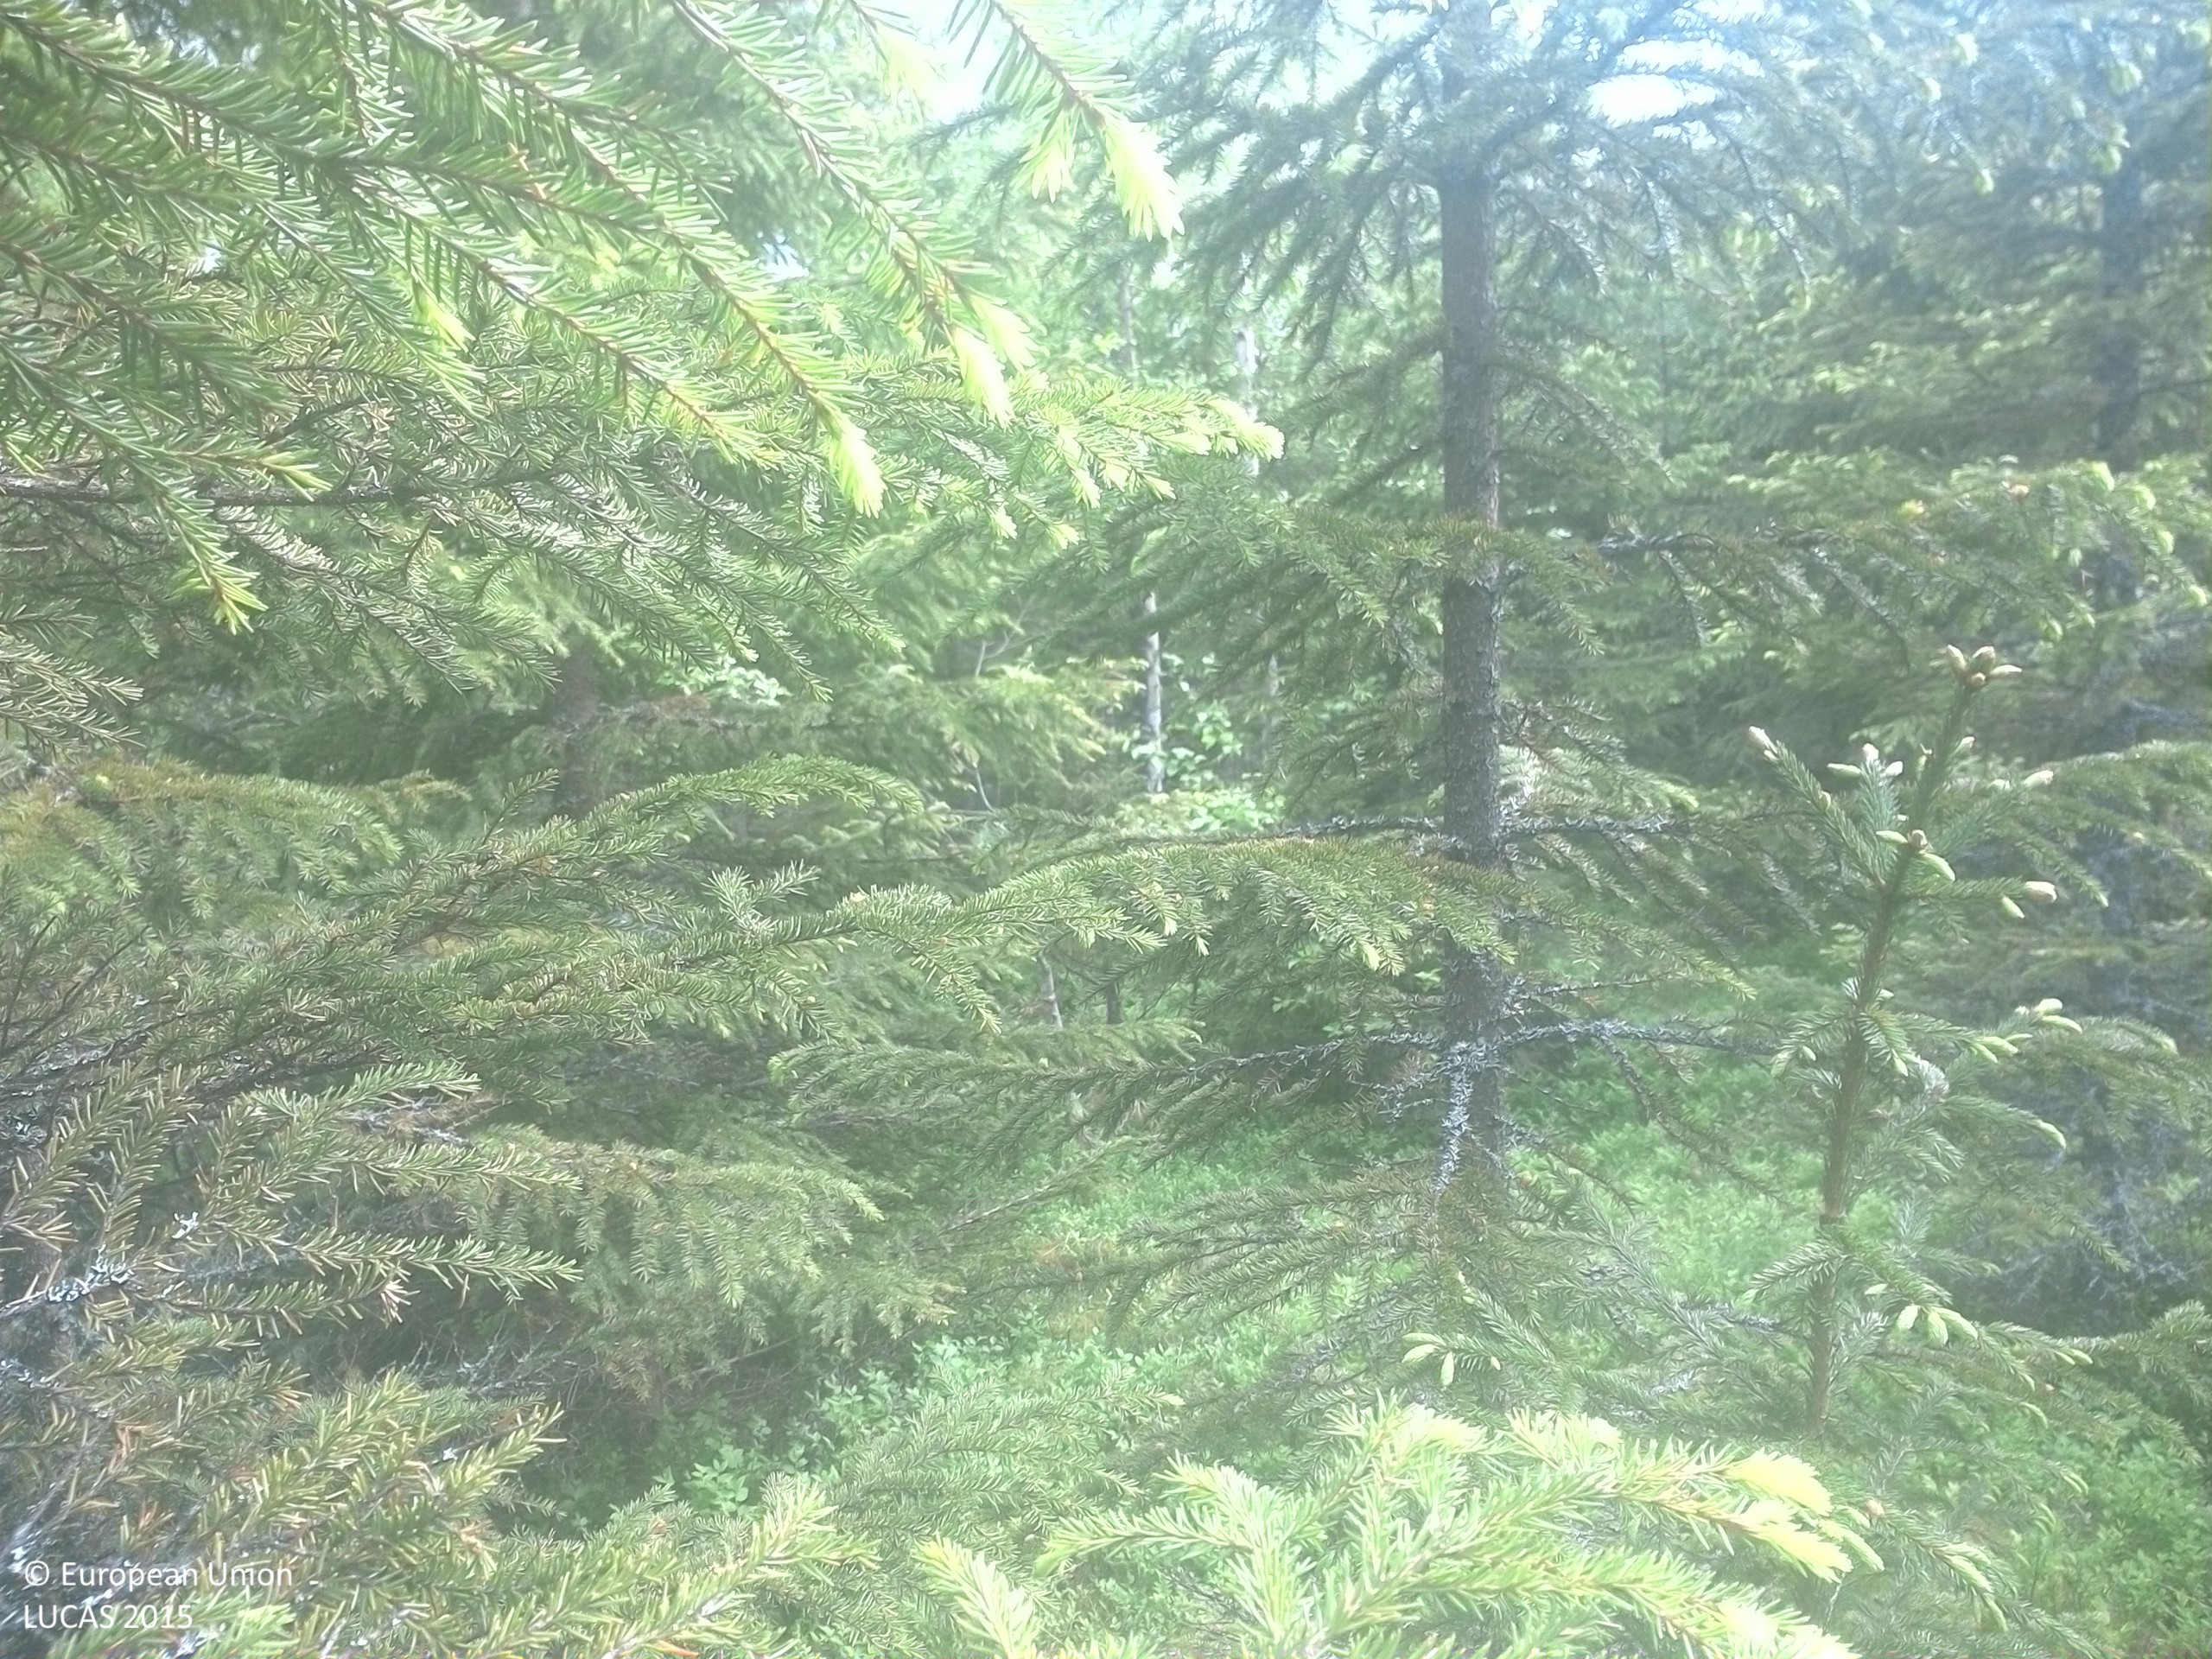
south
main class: Woodland
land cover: Spruce dominated mixed woodland
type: boreal forest
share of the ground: > 75 %
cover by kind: coniferous forest trees 55 %, shrubs 25 %, broadleaved forest trees 20 %
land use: Forestry
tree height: > 5 m
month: June
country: SE
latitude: 63.4611
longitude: 17.8183
